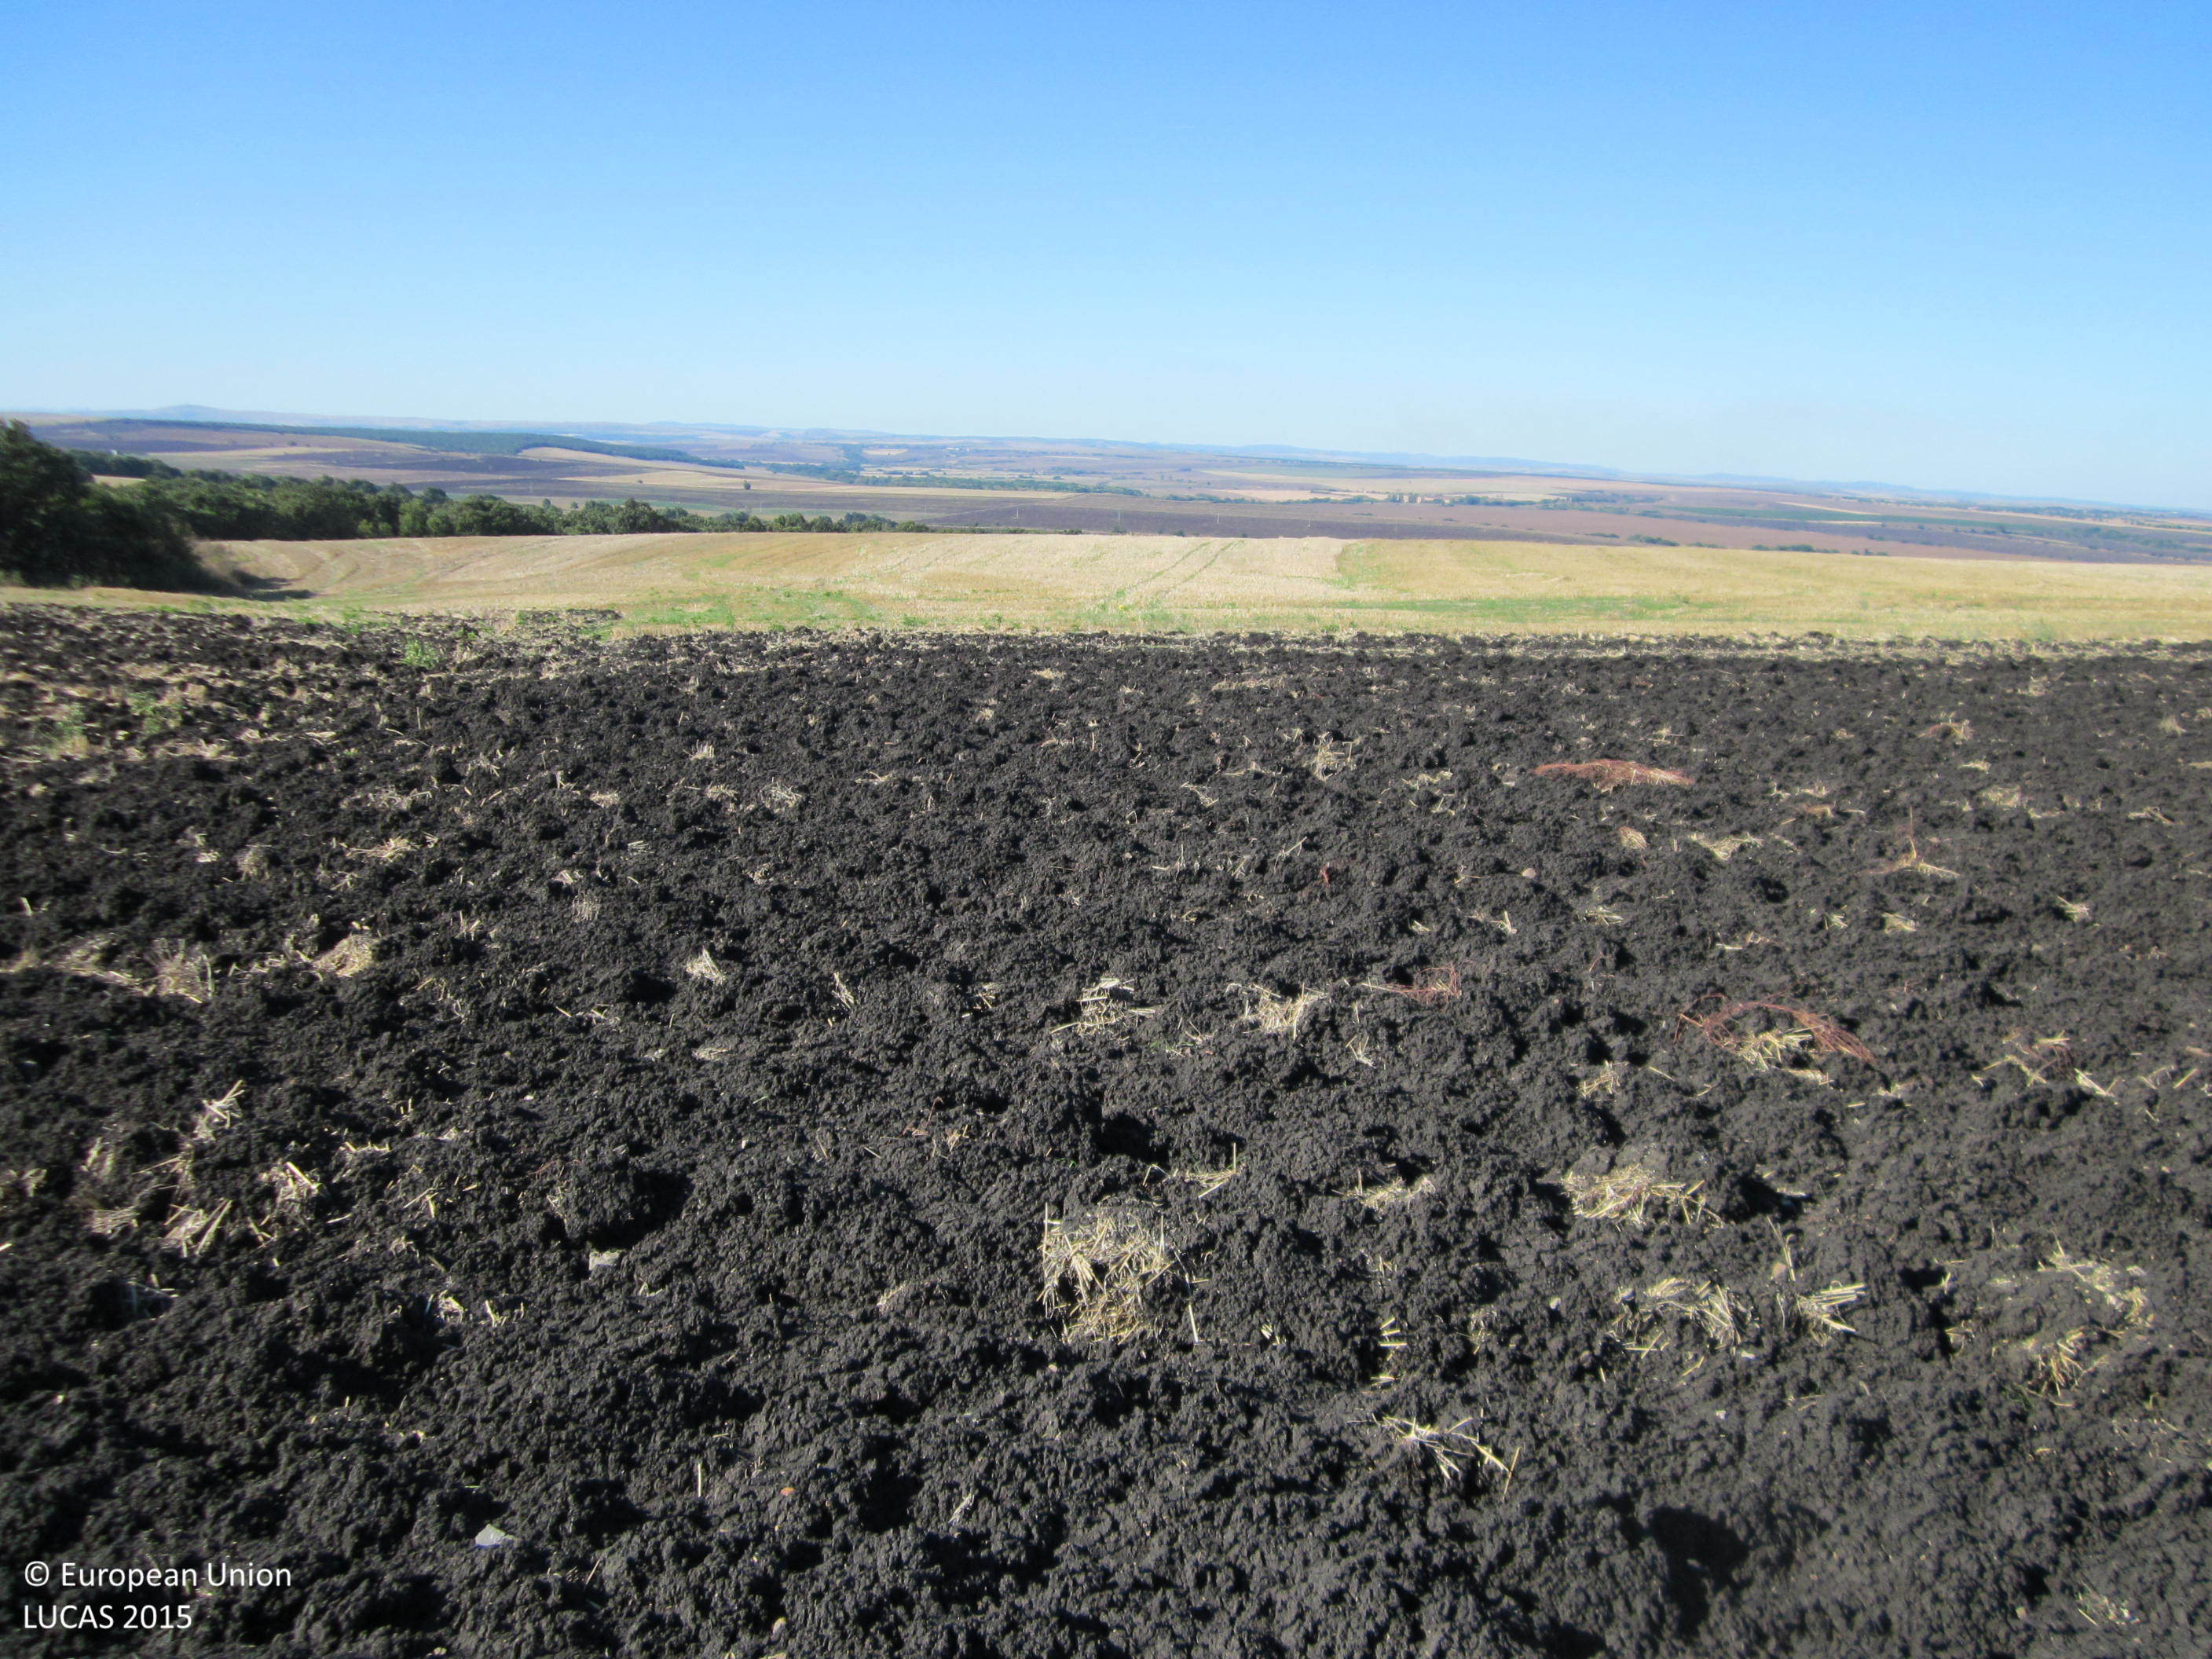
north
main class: Cropland
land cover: Common wheat
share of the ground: < 10 %
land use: Agriculture (excluding fallow land and kitchen gardens)
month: September
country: BG
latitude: 42.4629
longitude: 27.0710
